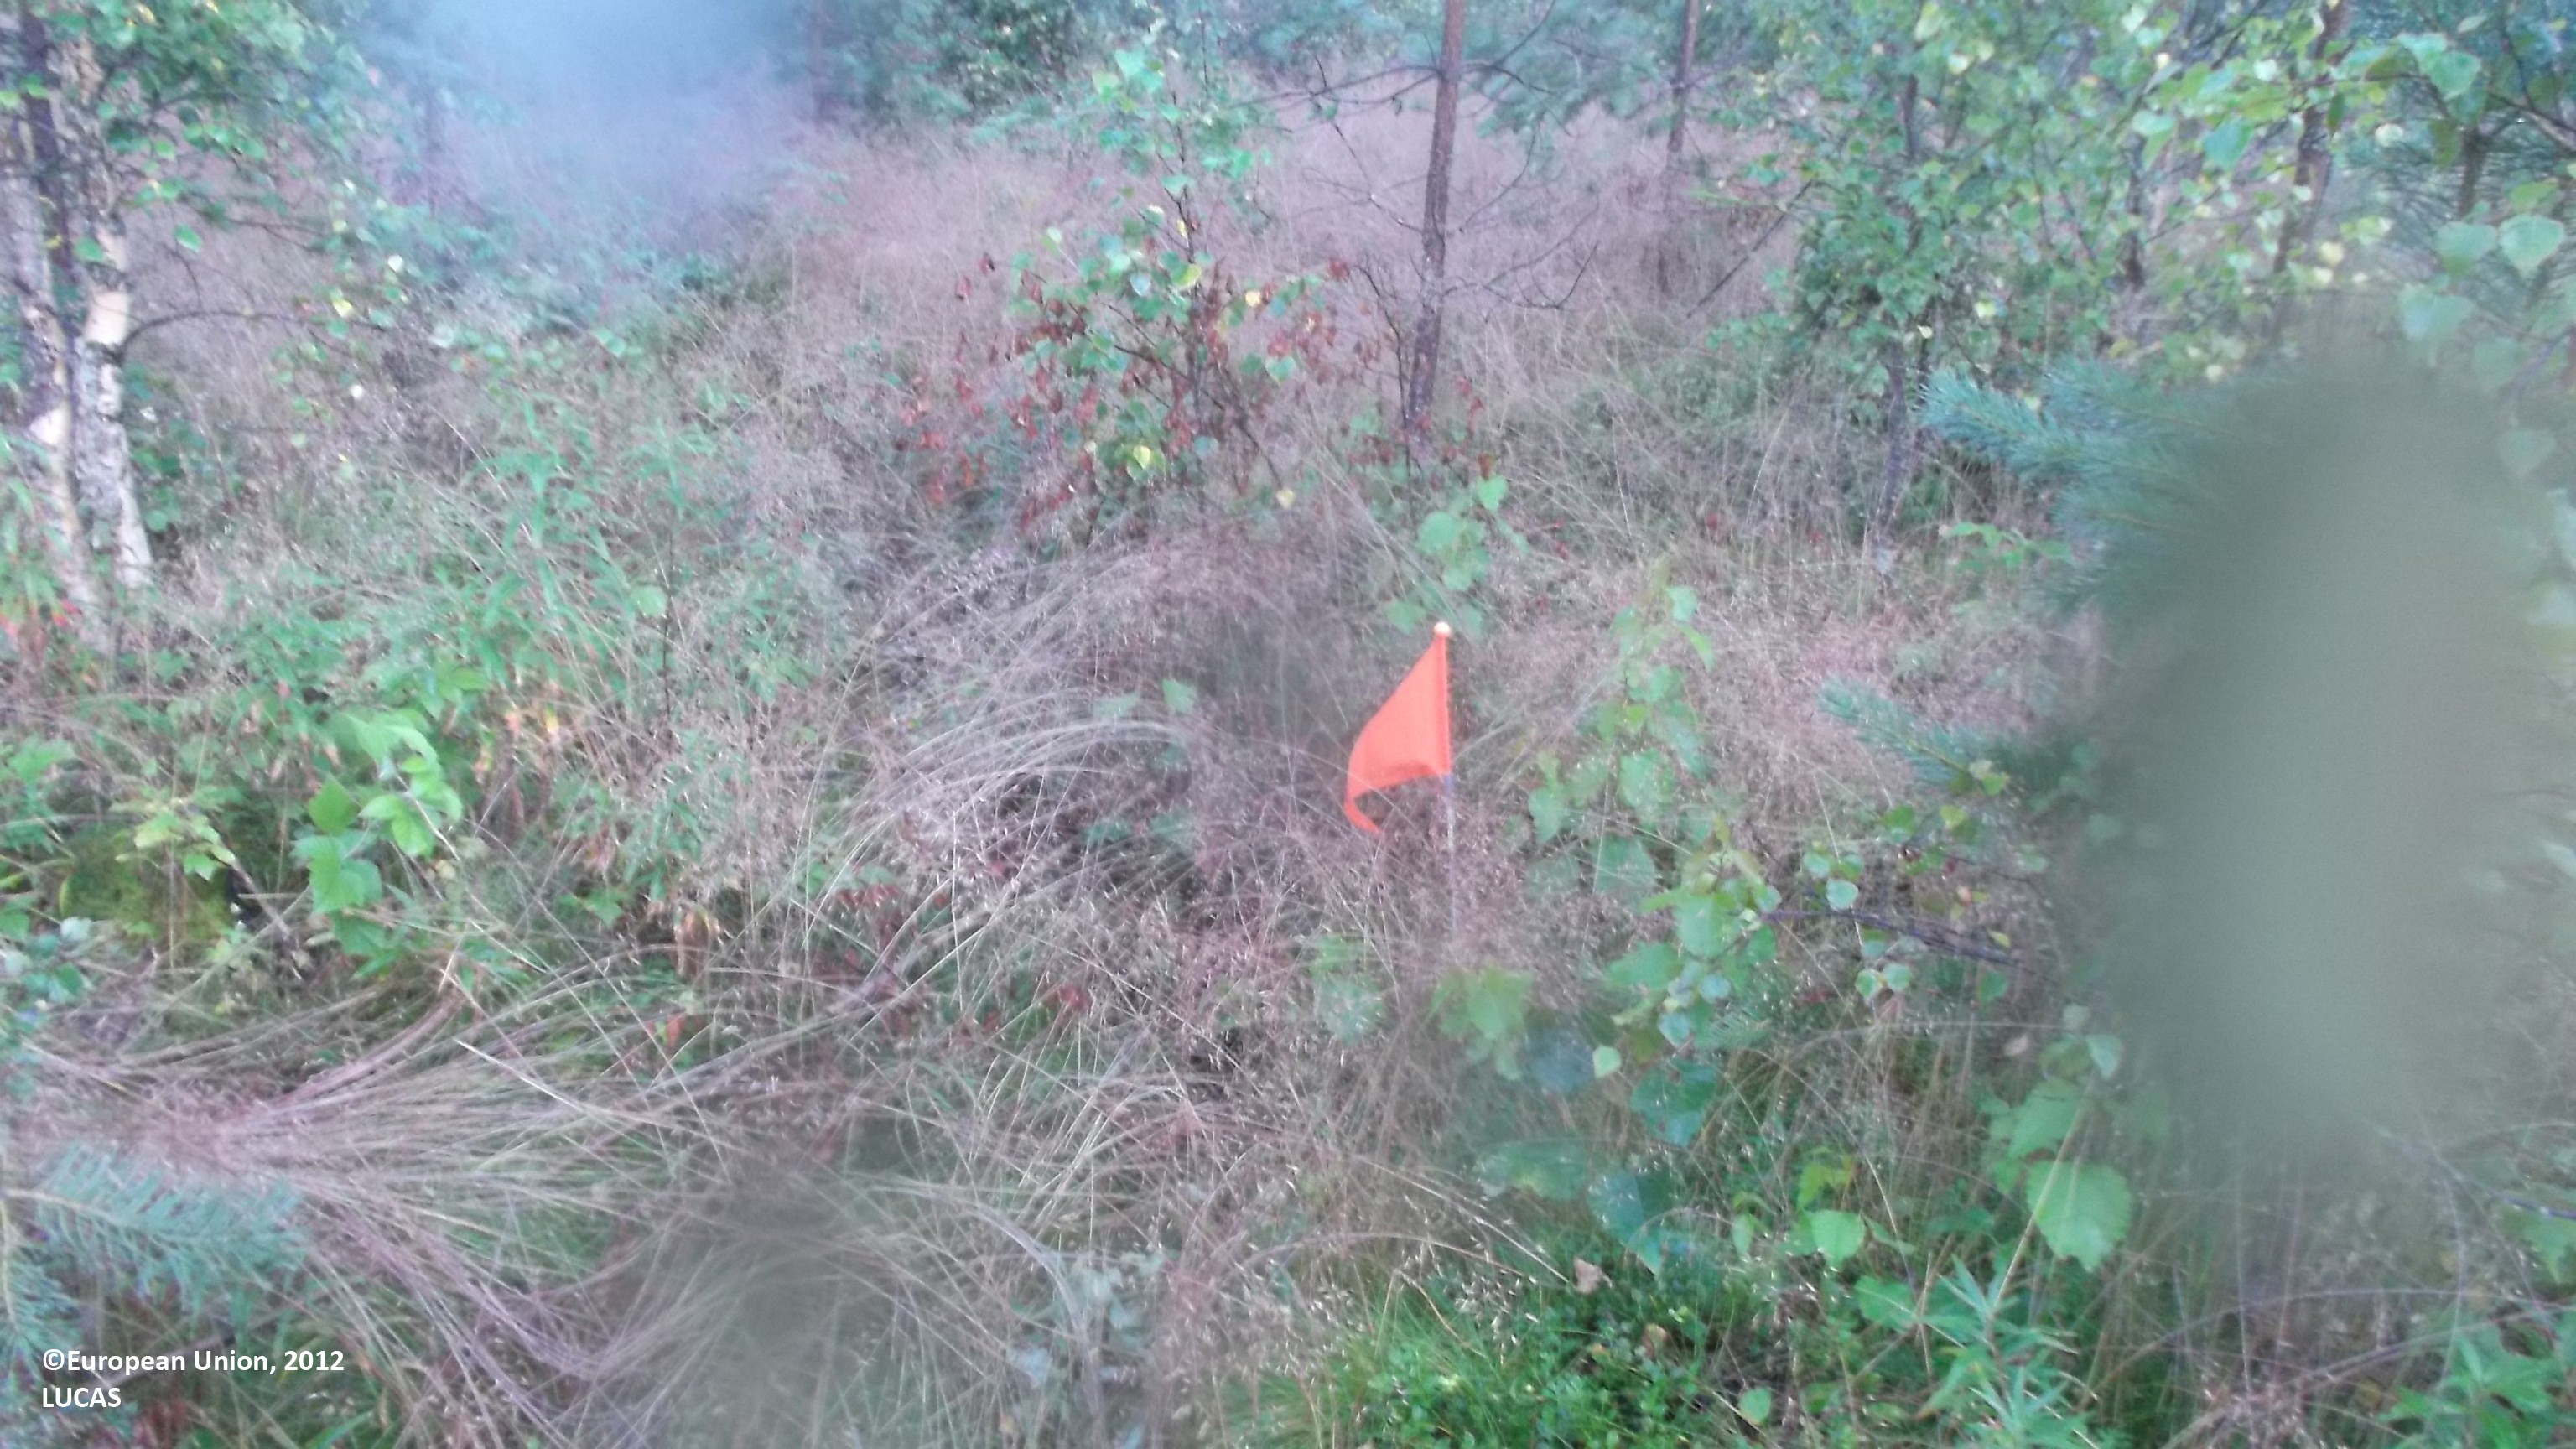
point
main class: Woodland
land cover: Other mixed woodland
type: boreal forest
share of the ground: 50 - 75 %
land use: Forestry
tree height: < 5 m
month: August
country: FI
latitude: 63.7413
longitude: 23.3264
